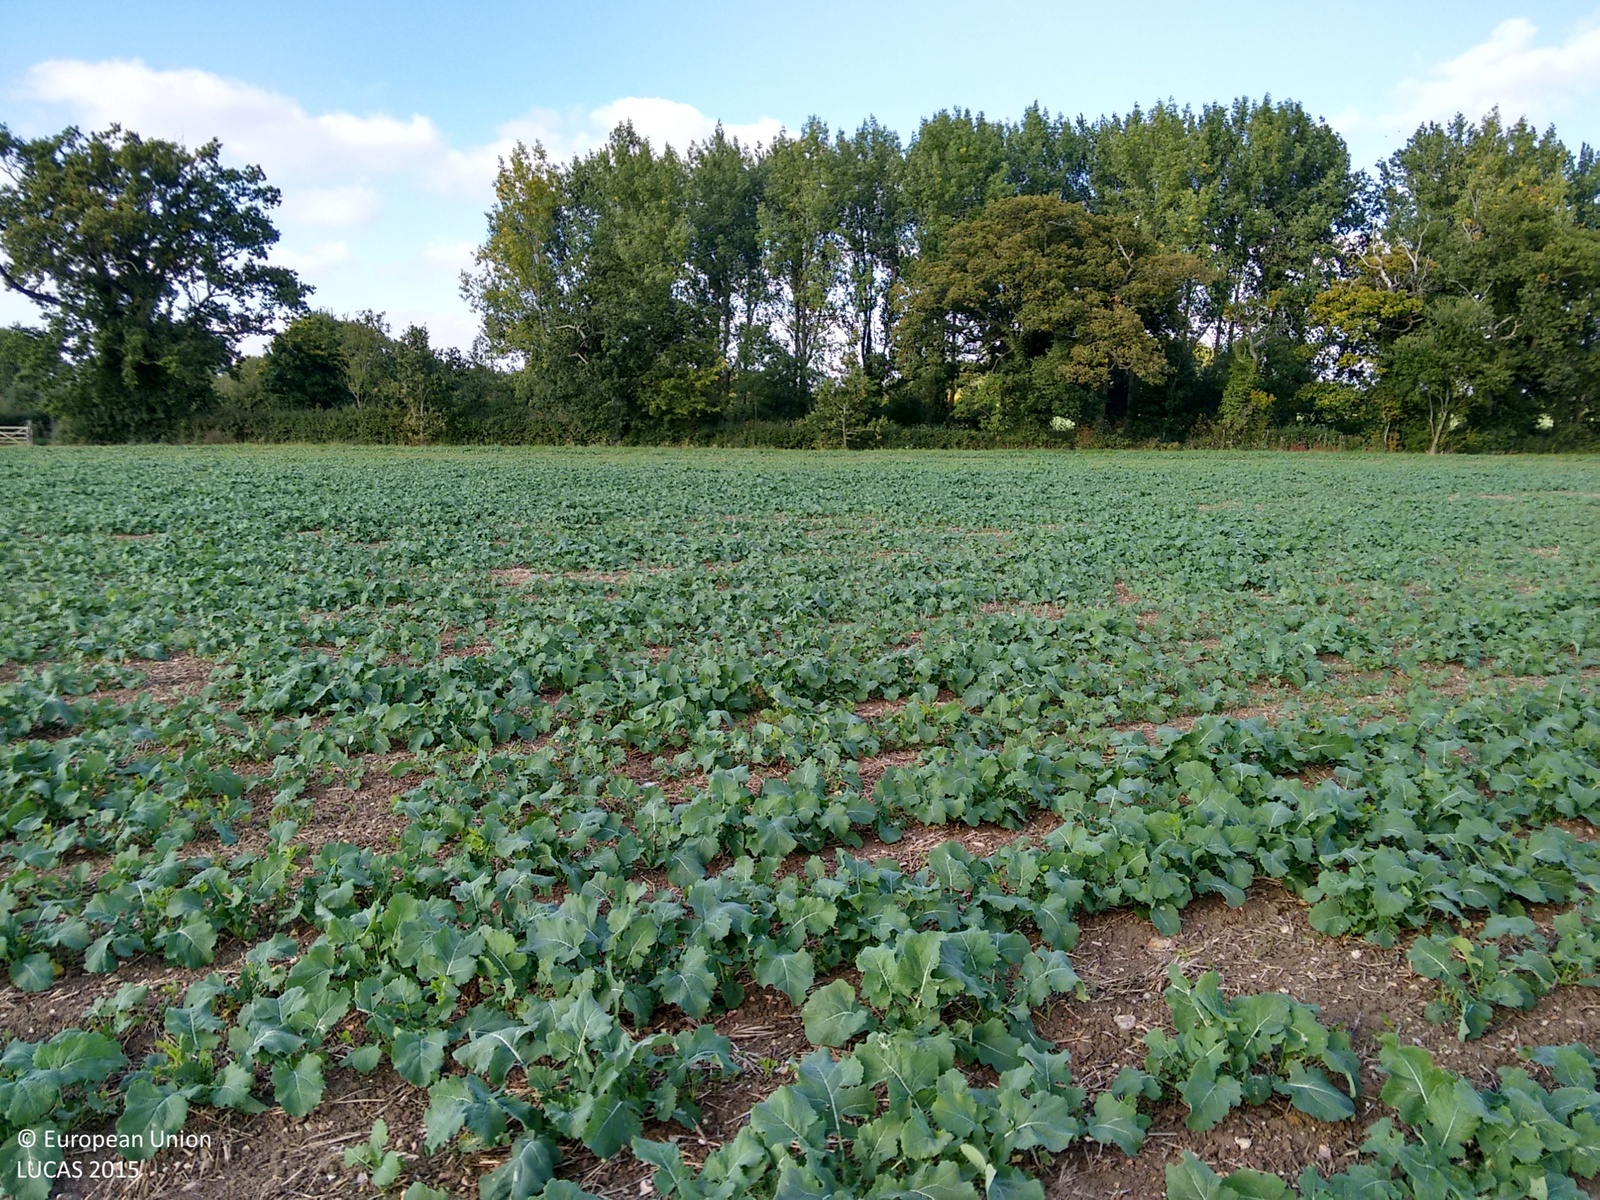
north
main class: Cropland
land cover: Rape and turnip rape
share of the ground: 50 - 75 %
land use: Agriculture (excluding fallow land and kitchen gardens)
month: October
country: GB
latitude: 52.4606
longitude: 1.3701
